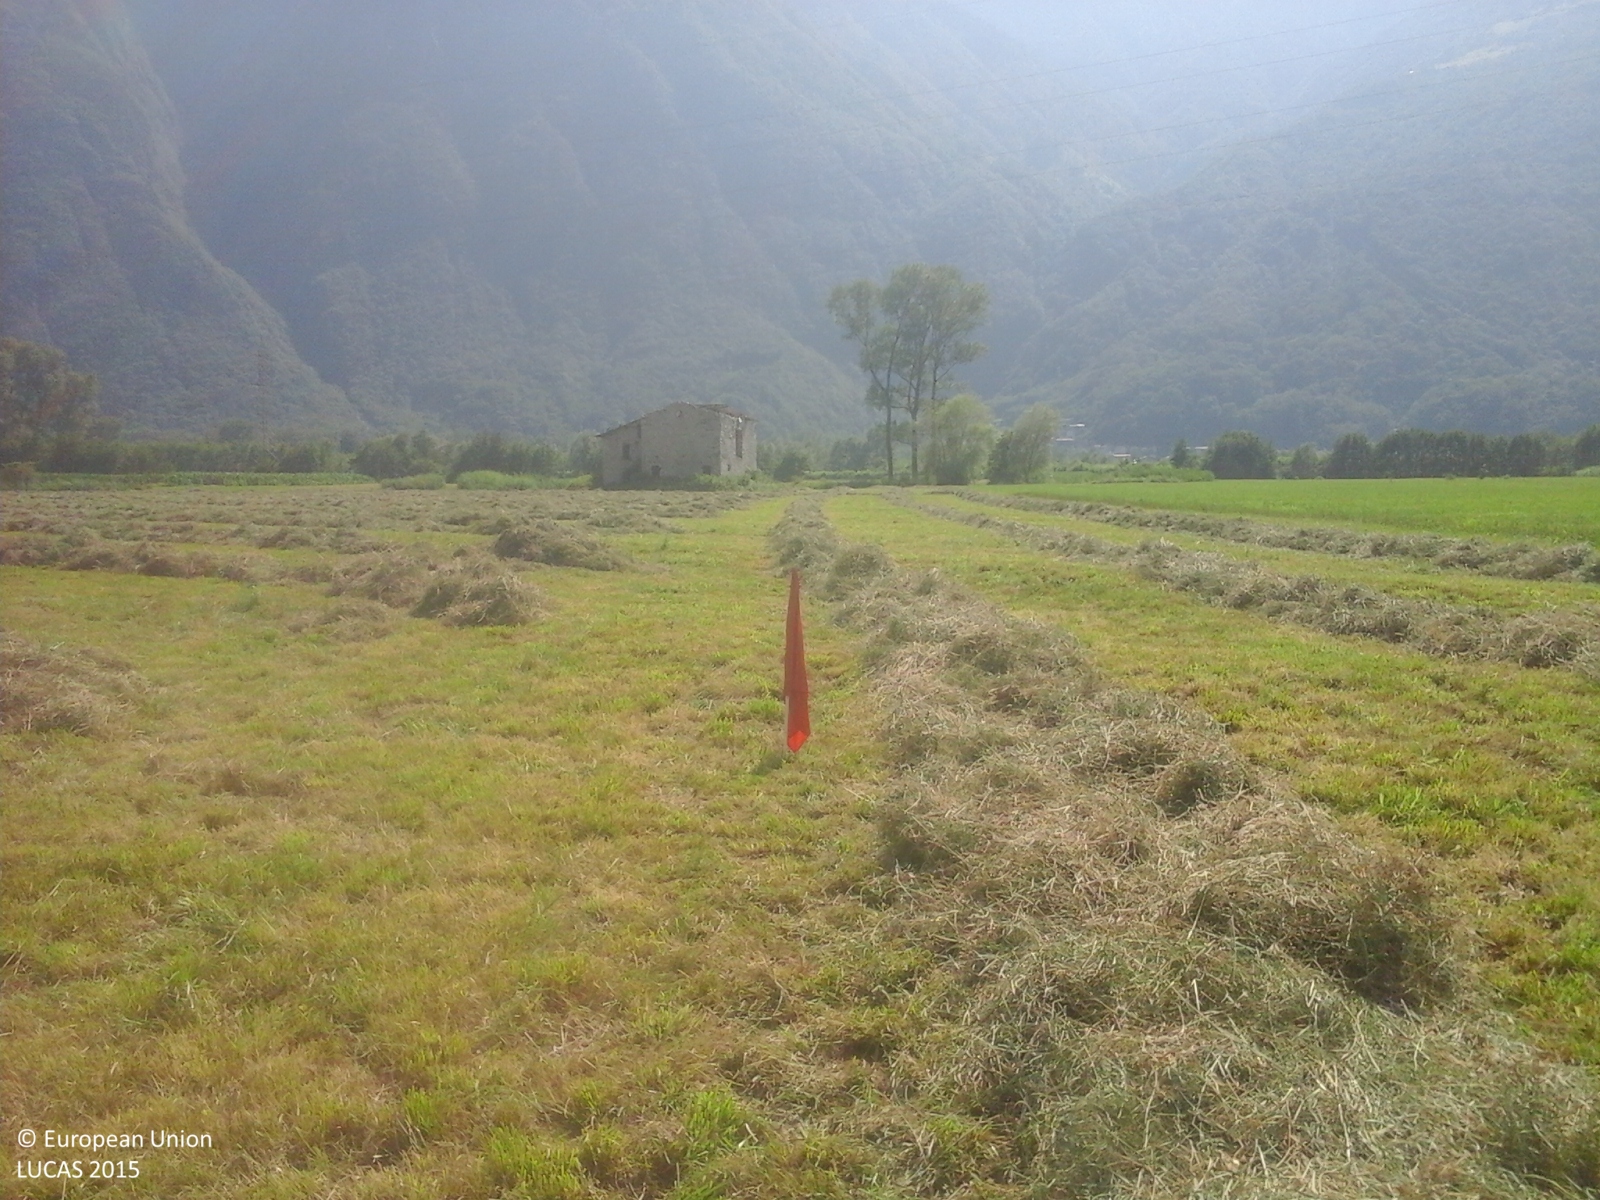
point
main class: Grassland
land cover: Grassland without tree/shrub cover
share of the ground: > 75 %
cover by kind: herbaceous plants 100 %
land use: Agriculture (excluding fallow land and kitchen gardens)
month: July
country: IT
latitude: 46.2415
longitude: 9.4172
